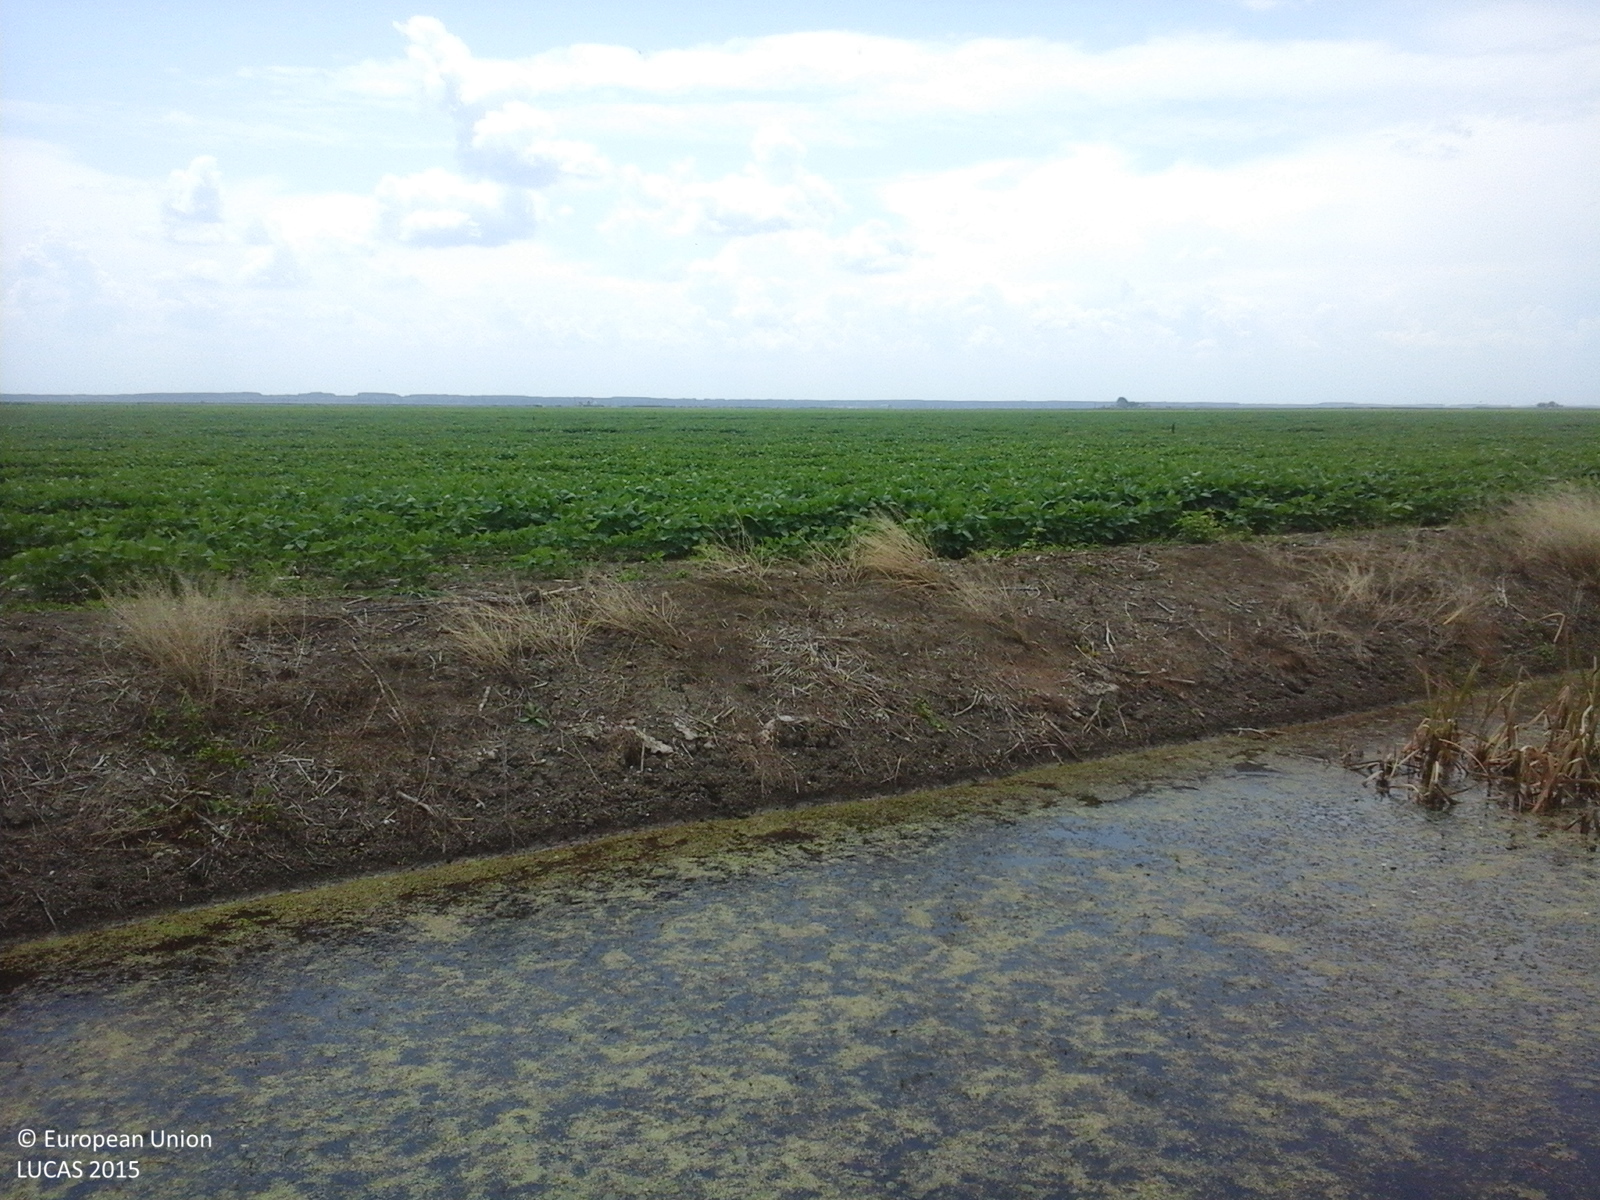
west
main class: Cropland
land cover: Soya
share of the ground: > 75 %
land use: Agriculture (excluding fallow land and kitchen gardens)
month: June
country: RO
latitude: 44.1029
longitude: 26.3863
